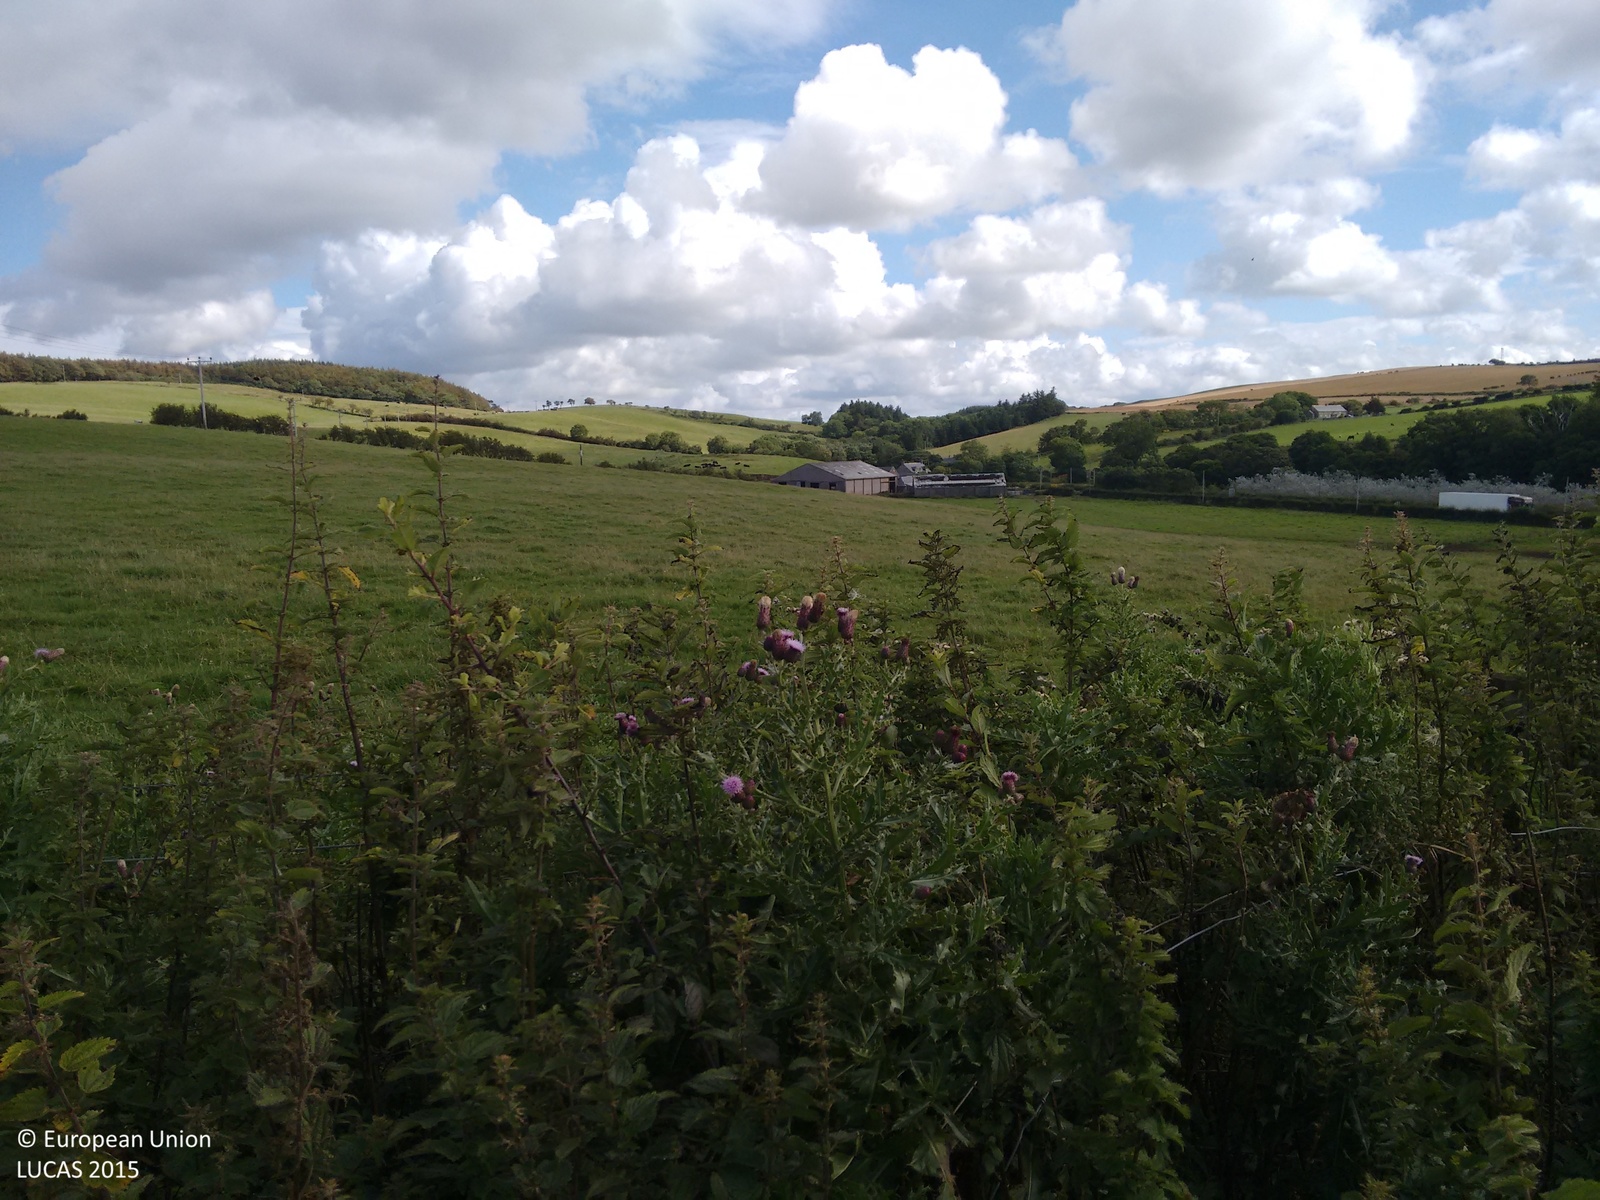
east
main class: Grassland
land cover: Grassland without tree/shrub cover
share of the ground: > 75 %
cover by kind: herbaceous plants 100 %
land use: Agriculture (excluding fallow land and kitchen gardens)
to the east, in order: Grassland without tree/shrub cover; Fences; Conifer hedges; Grassland without tree/shrub cover
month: August
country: GB
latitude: 55.3213
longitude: -4.8114
